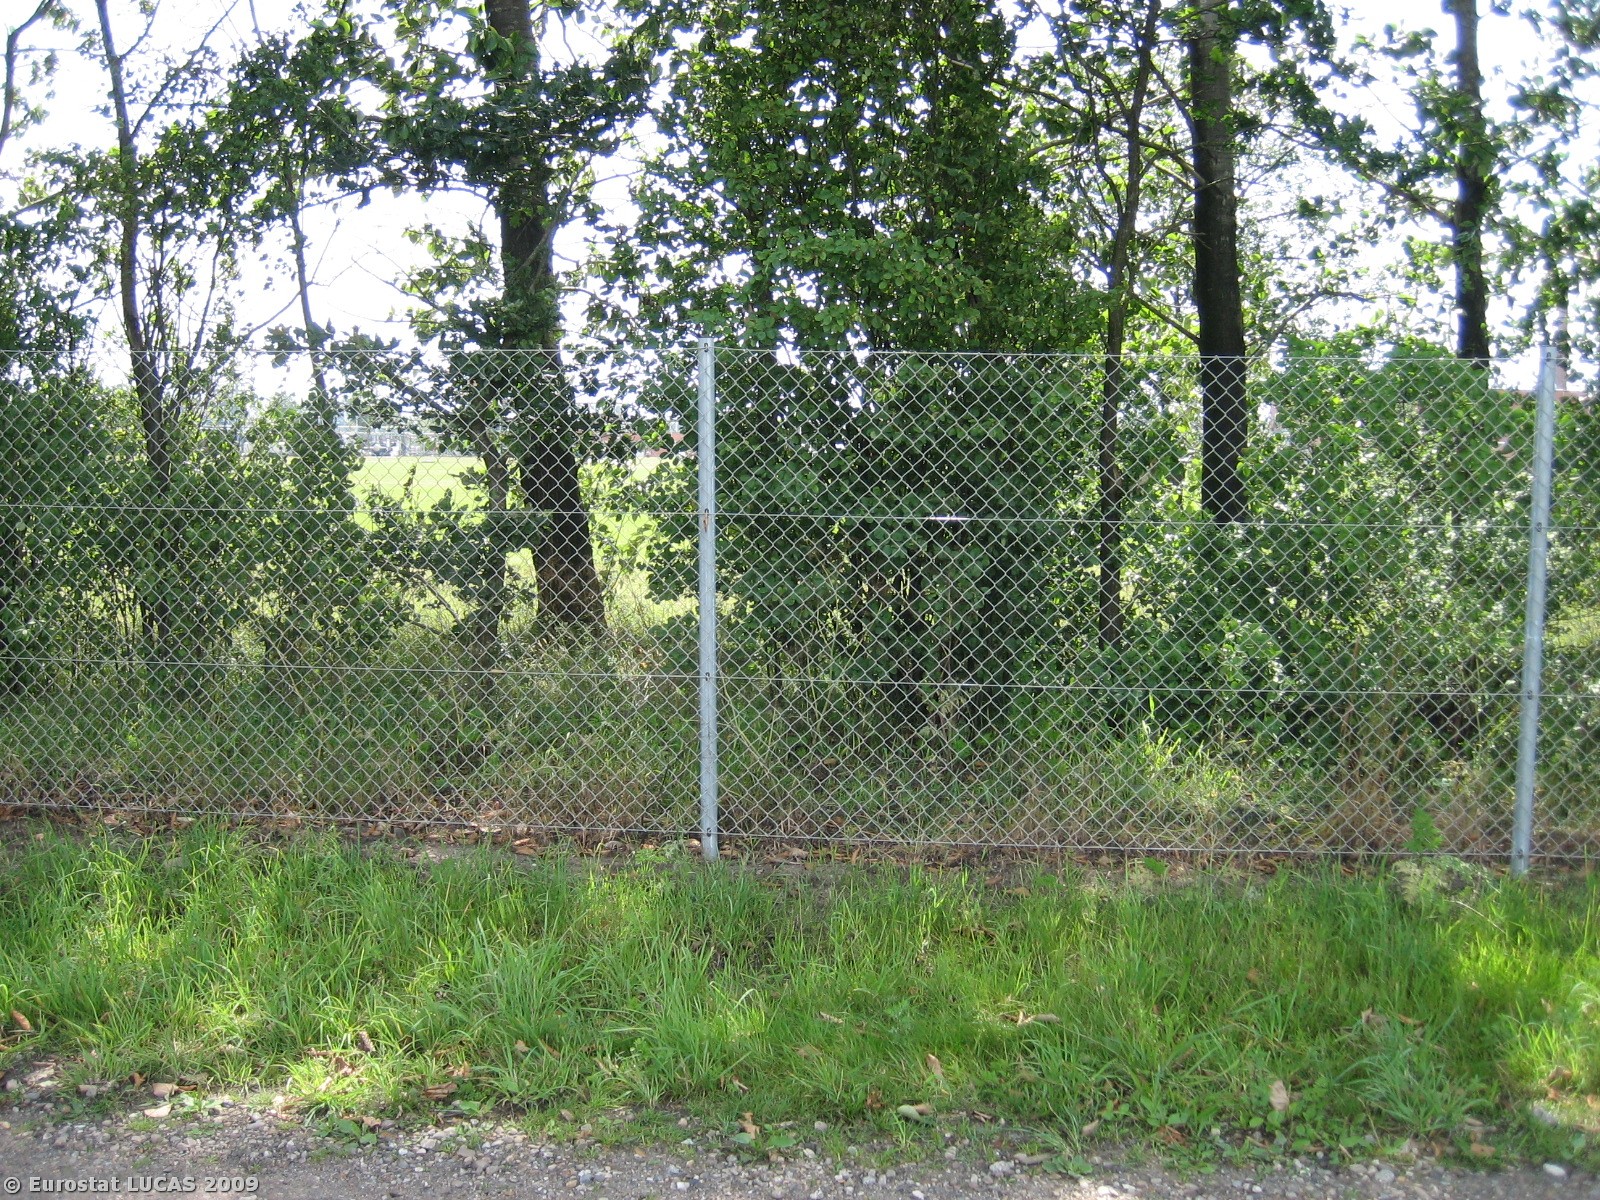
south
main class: Cropland
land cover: Potatoes
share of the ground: > 75 %
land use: Agriculture (excluding fallow land and kitchen gardens)
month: July
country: DK
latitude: 55.7698
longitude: 8.9331
